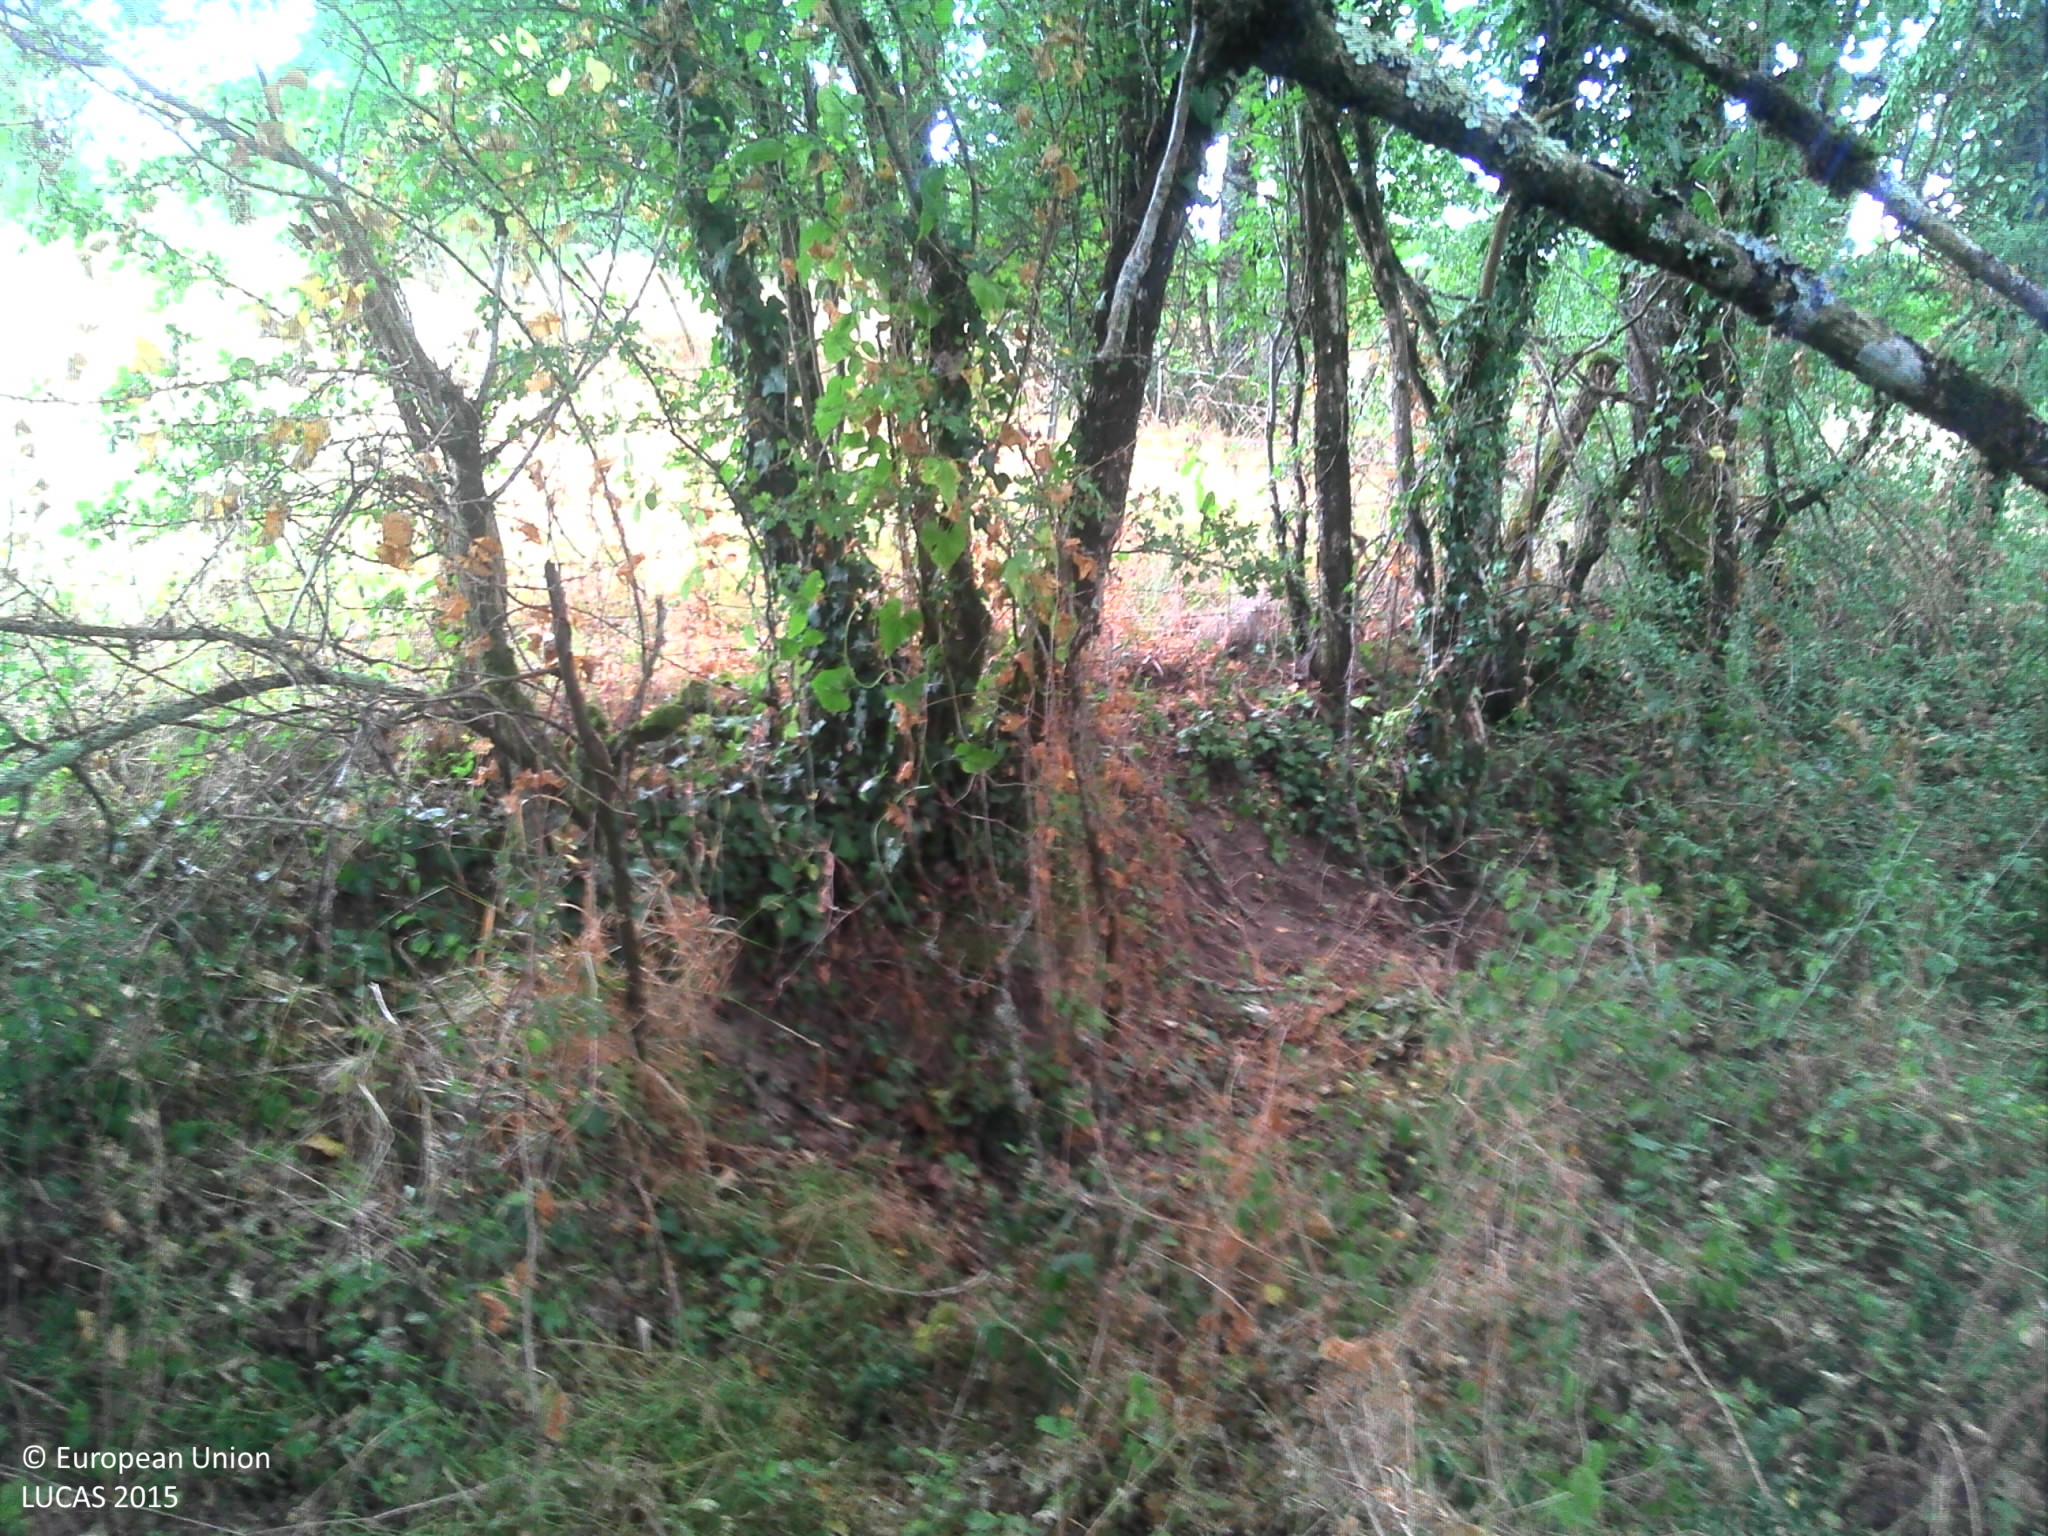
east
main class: Woodland
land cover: Broadleaved woodland
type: mesophytic deciduous forest
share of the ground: > 75 %
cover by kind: broadleaved forest trees 80 %, herbaceous plants 15 %
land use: Forestry
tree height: > 5 m
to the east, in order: Broadleaved woodland; Fences; Grassland without tree/shrub cover; Fences; Broadleaved woodland; Common wheat; Fences; Broadleaved woodland; Fences; Grassland without tree/shrub cover; Spontaneously vegetated surfaces; Grassland without tree/shrub cover; Fences; Groves; Tracks; Broadleaved woodland
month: October
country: FR
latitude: 46.3316
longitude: 1.1940
